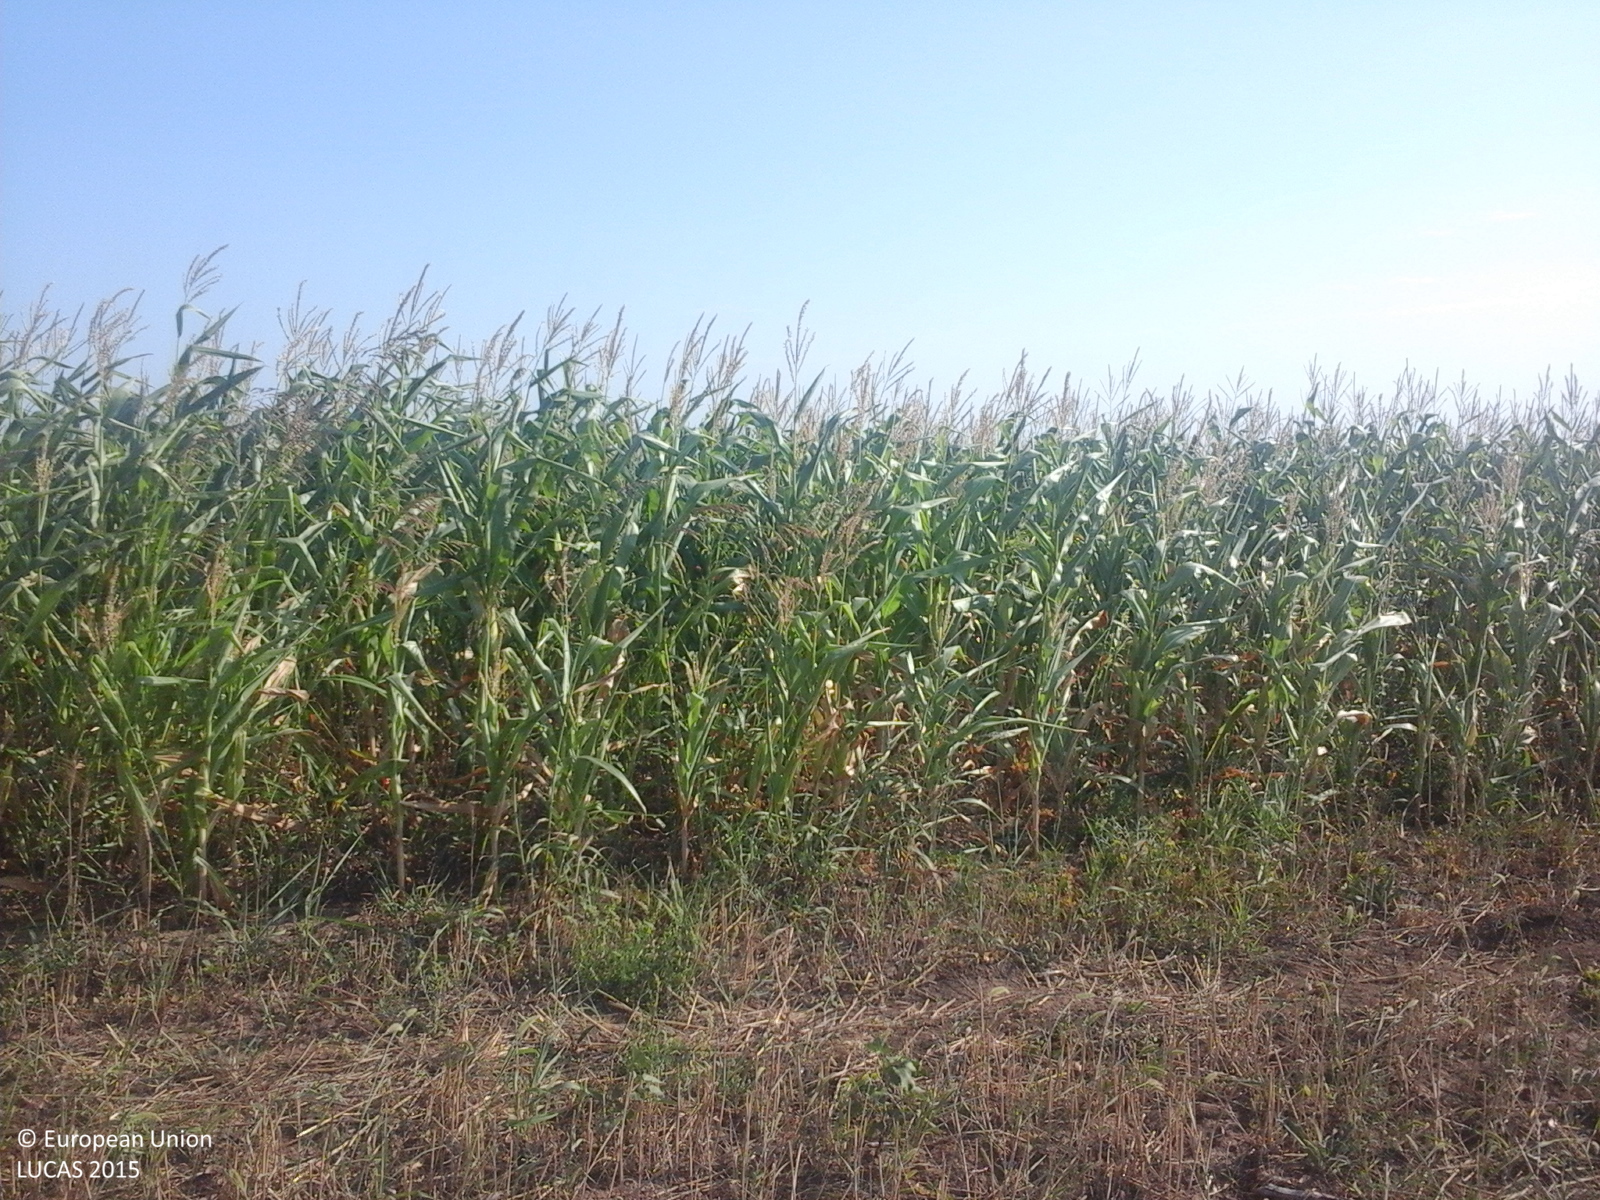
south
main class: Cropland
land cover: Maize
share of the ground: > 75 %
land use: Agriculture (excluding fallow land and kitchen gardens)
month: August
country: RO
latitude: 43.9187
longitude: 28.1257
